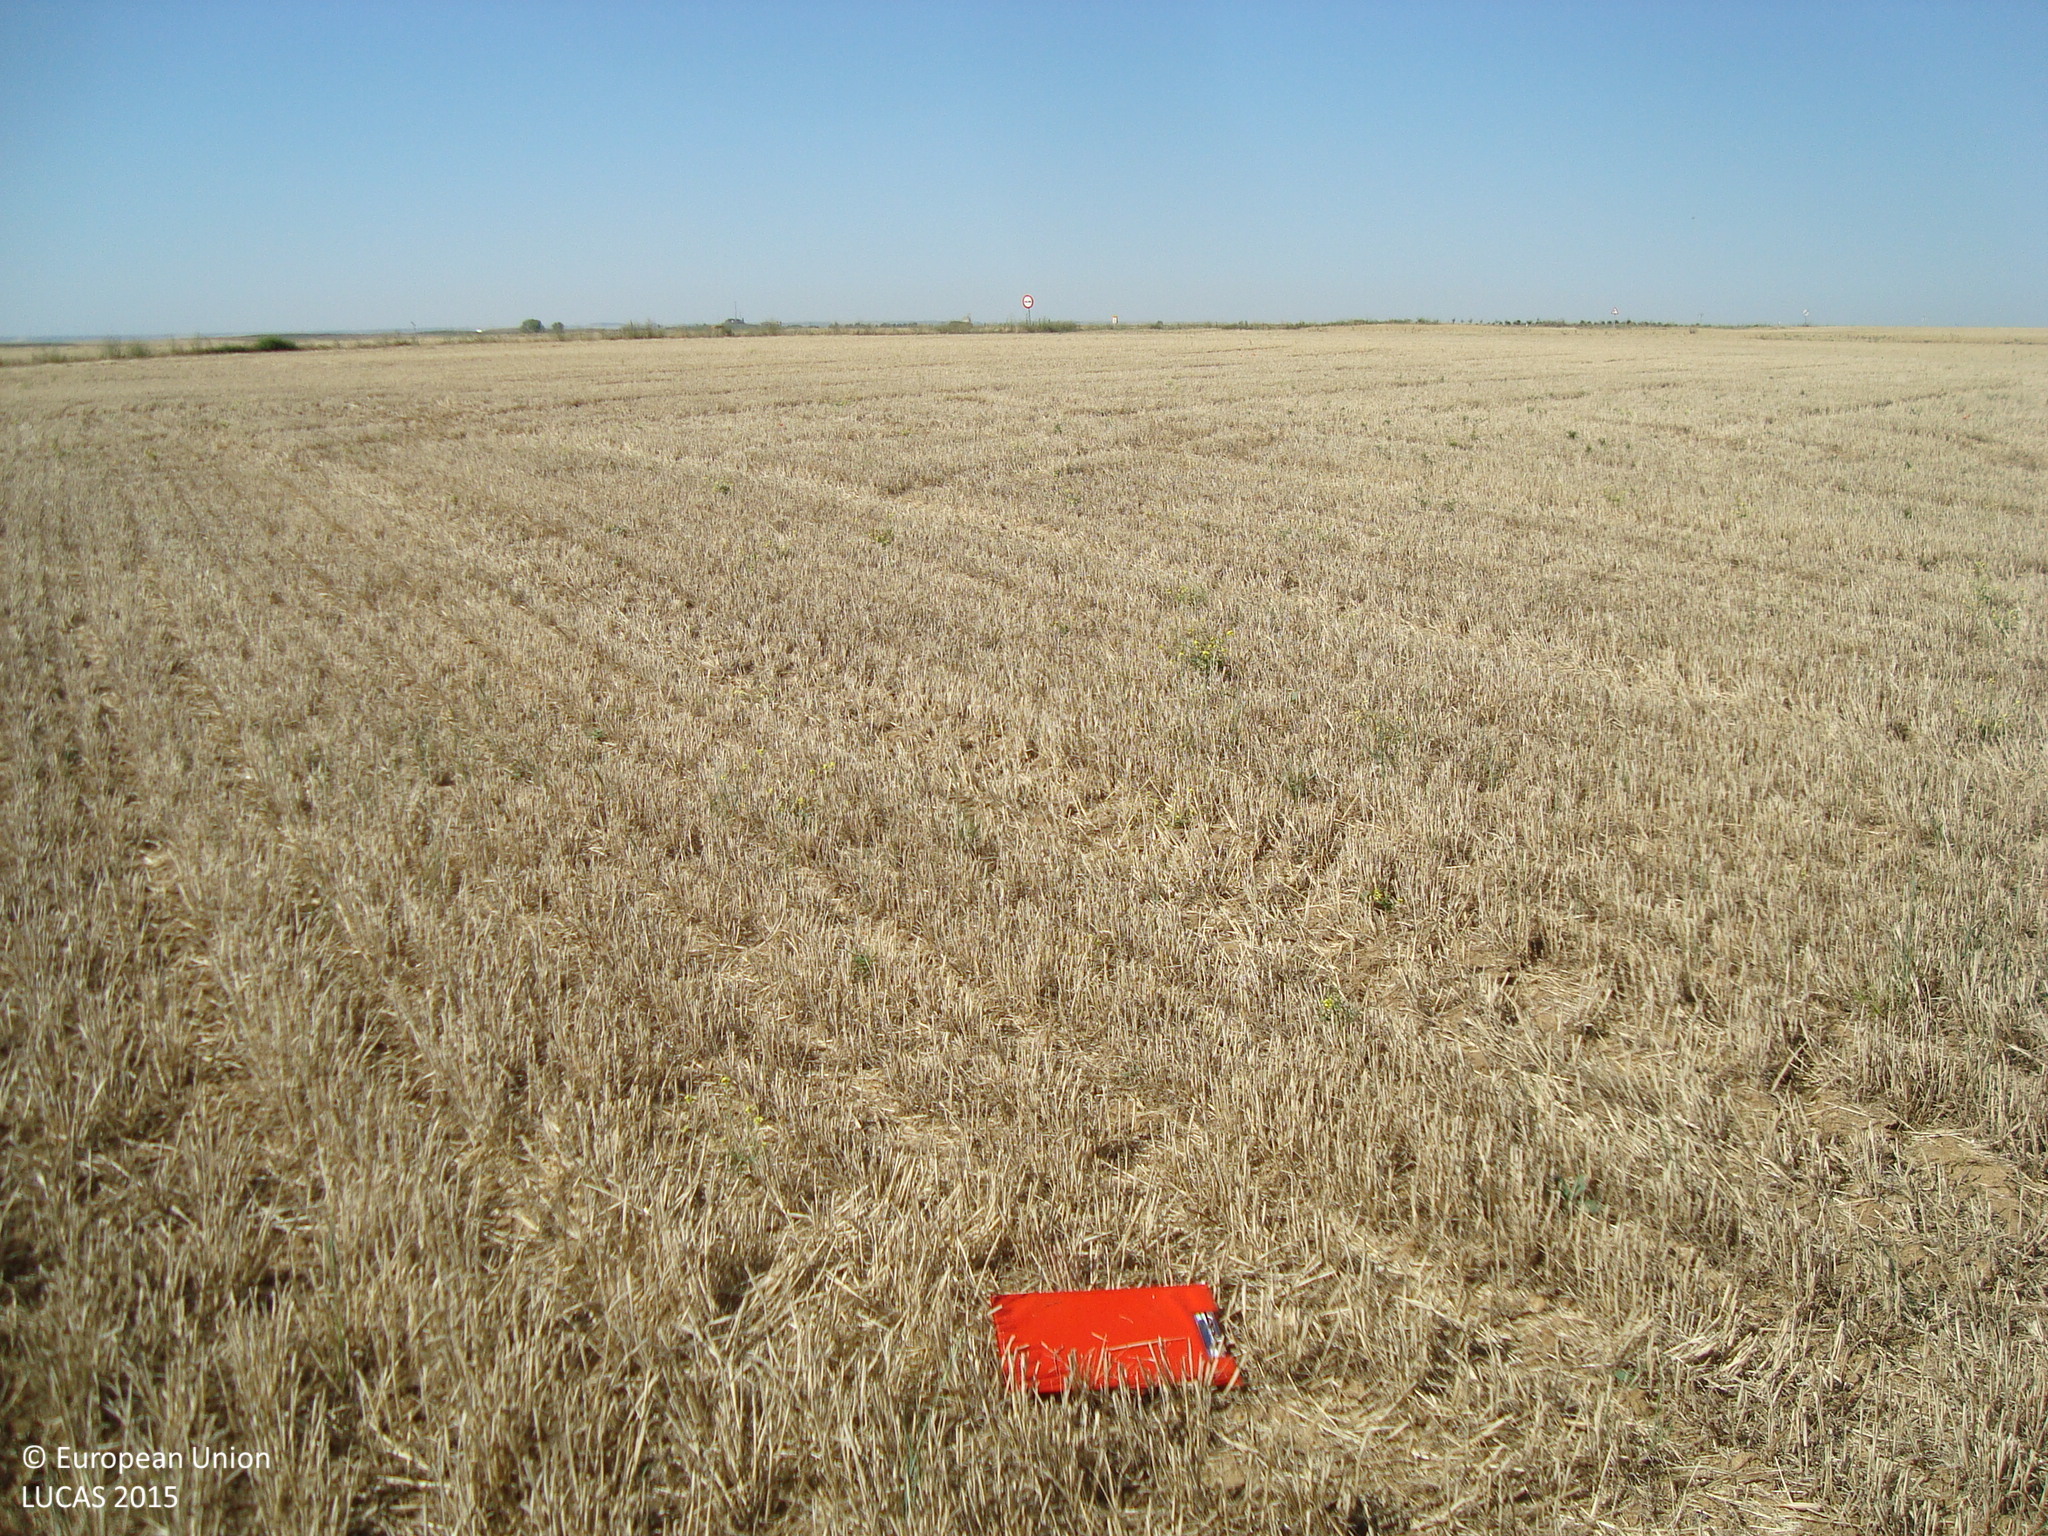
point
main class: Cropland
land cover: Barley
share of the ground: < 10 %
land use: Agriculture (excluding fallow land and kitchen gardens)
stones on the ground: < 10 %
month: July
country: ES
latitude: 42.0718
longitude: -4.8091
